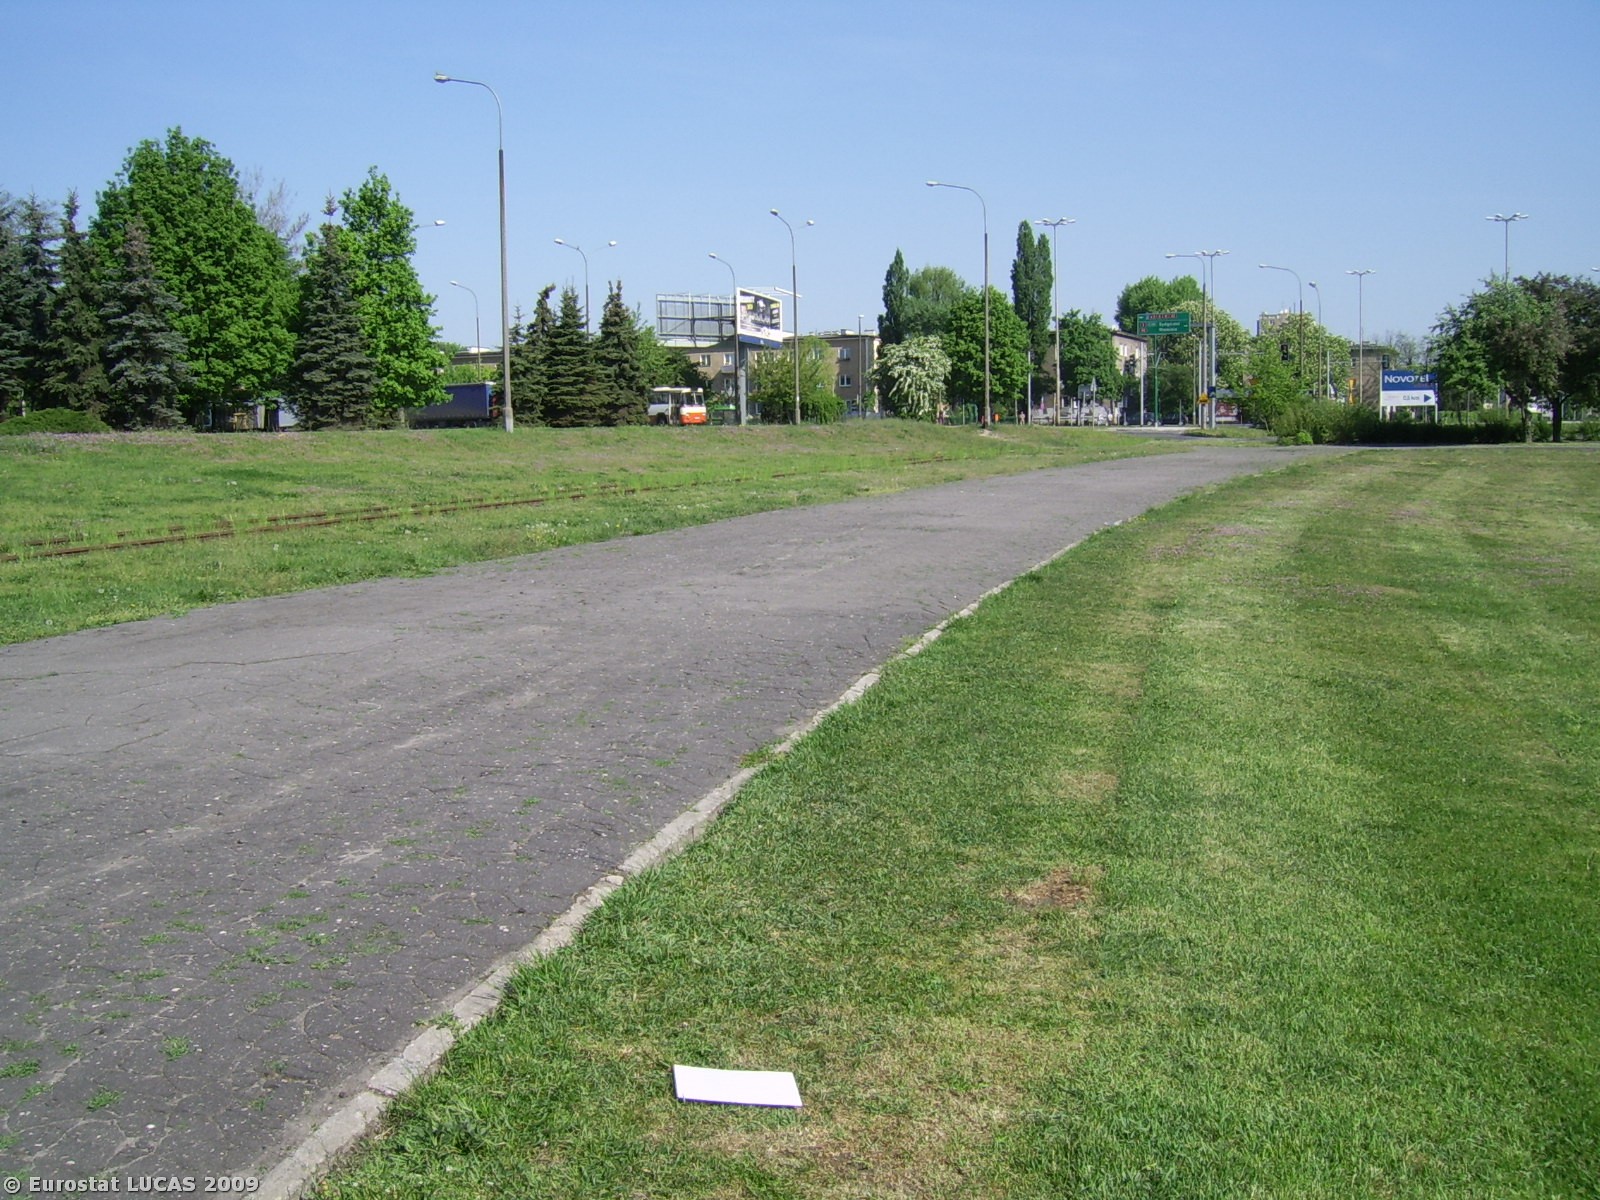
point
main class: Grassland
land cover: Grassland without tree/shrub cover
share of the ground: > 75 %
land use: Amenities, museums, leisure
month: May
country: PL
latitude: 52.4076
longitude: 16.9627
